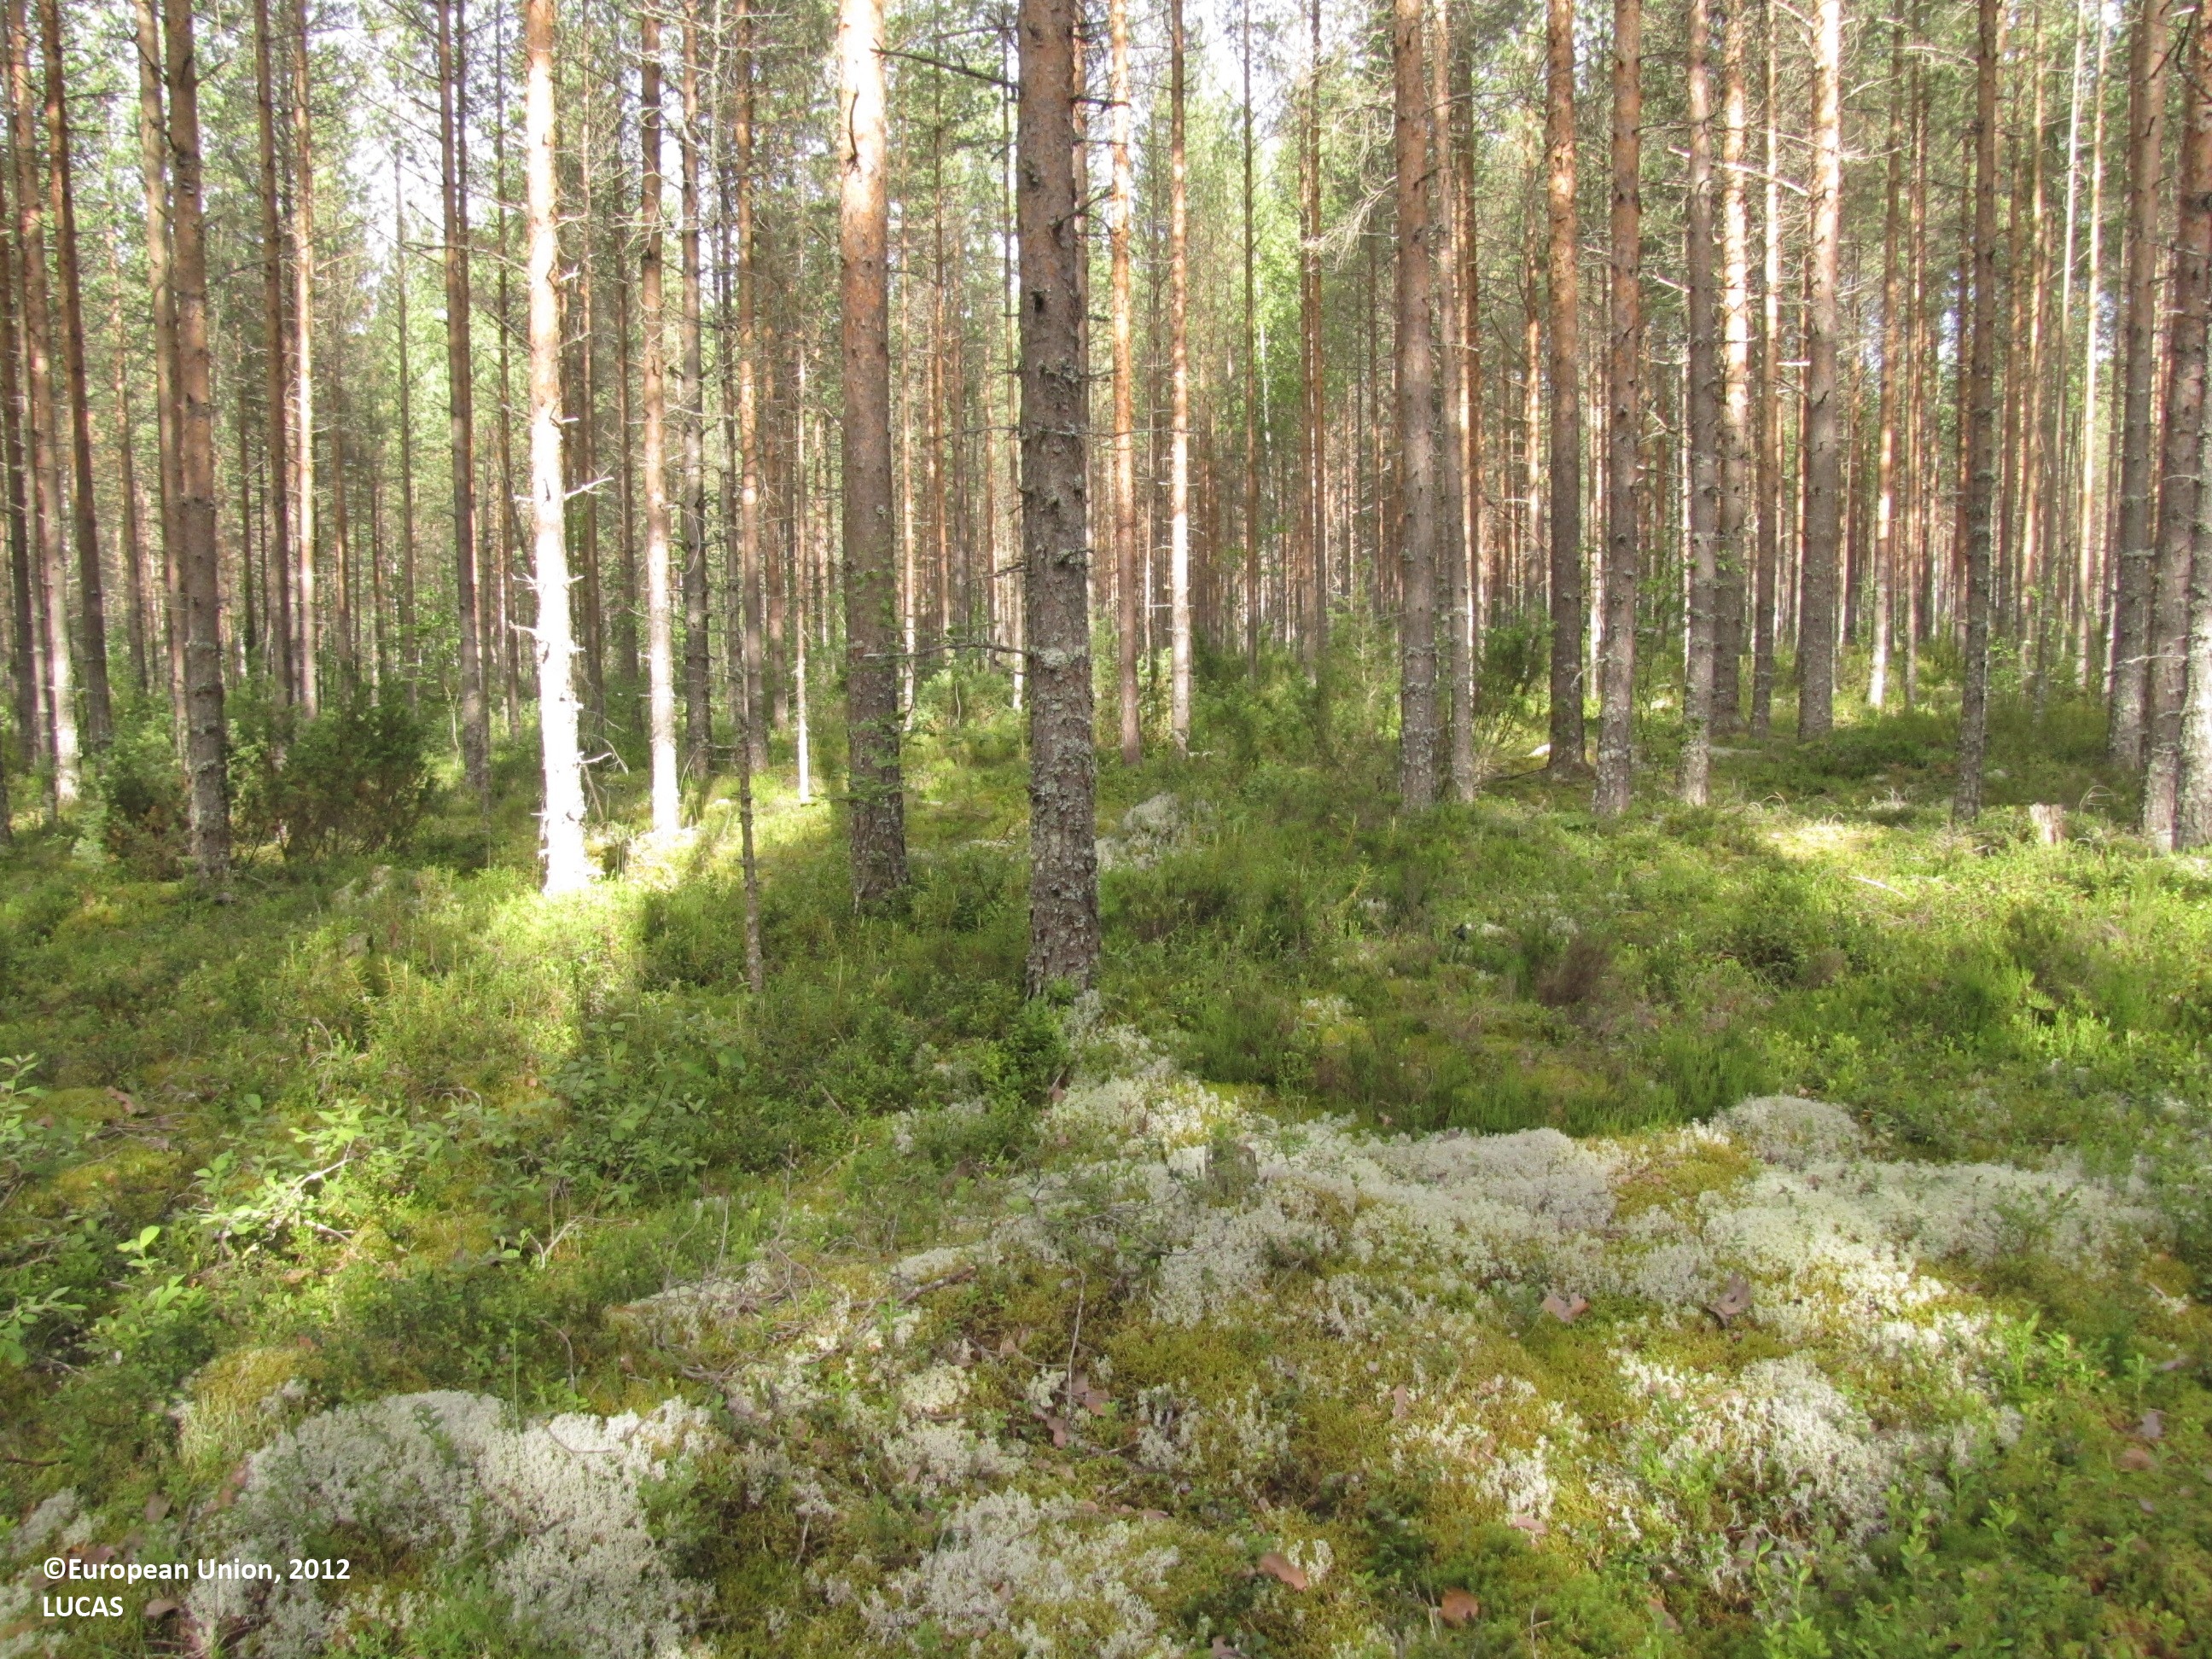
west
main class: Woodland
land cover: Pine dominated coniferous woodland
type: mire and swamp forests
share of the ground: > 75 %
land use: Forestry
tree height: > 5 m
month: July
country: FI
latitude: 62.4338
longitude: 23.3766
